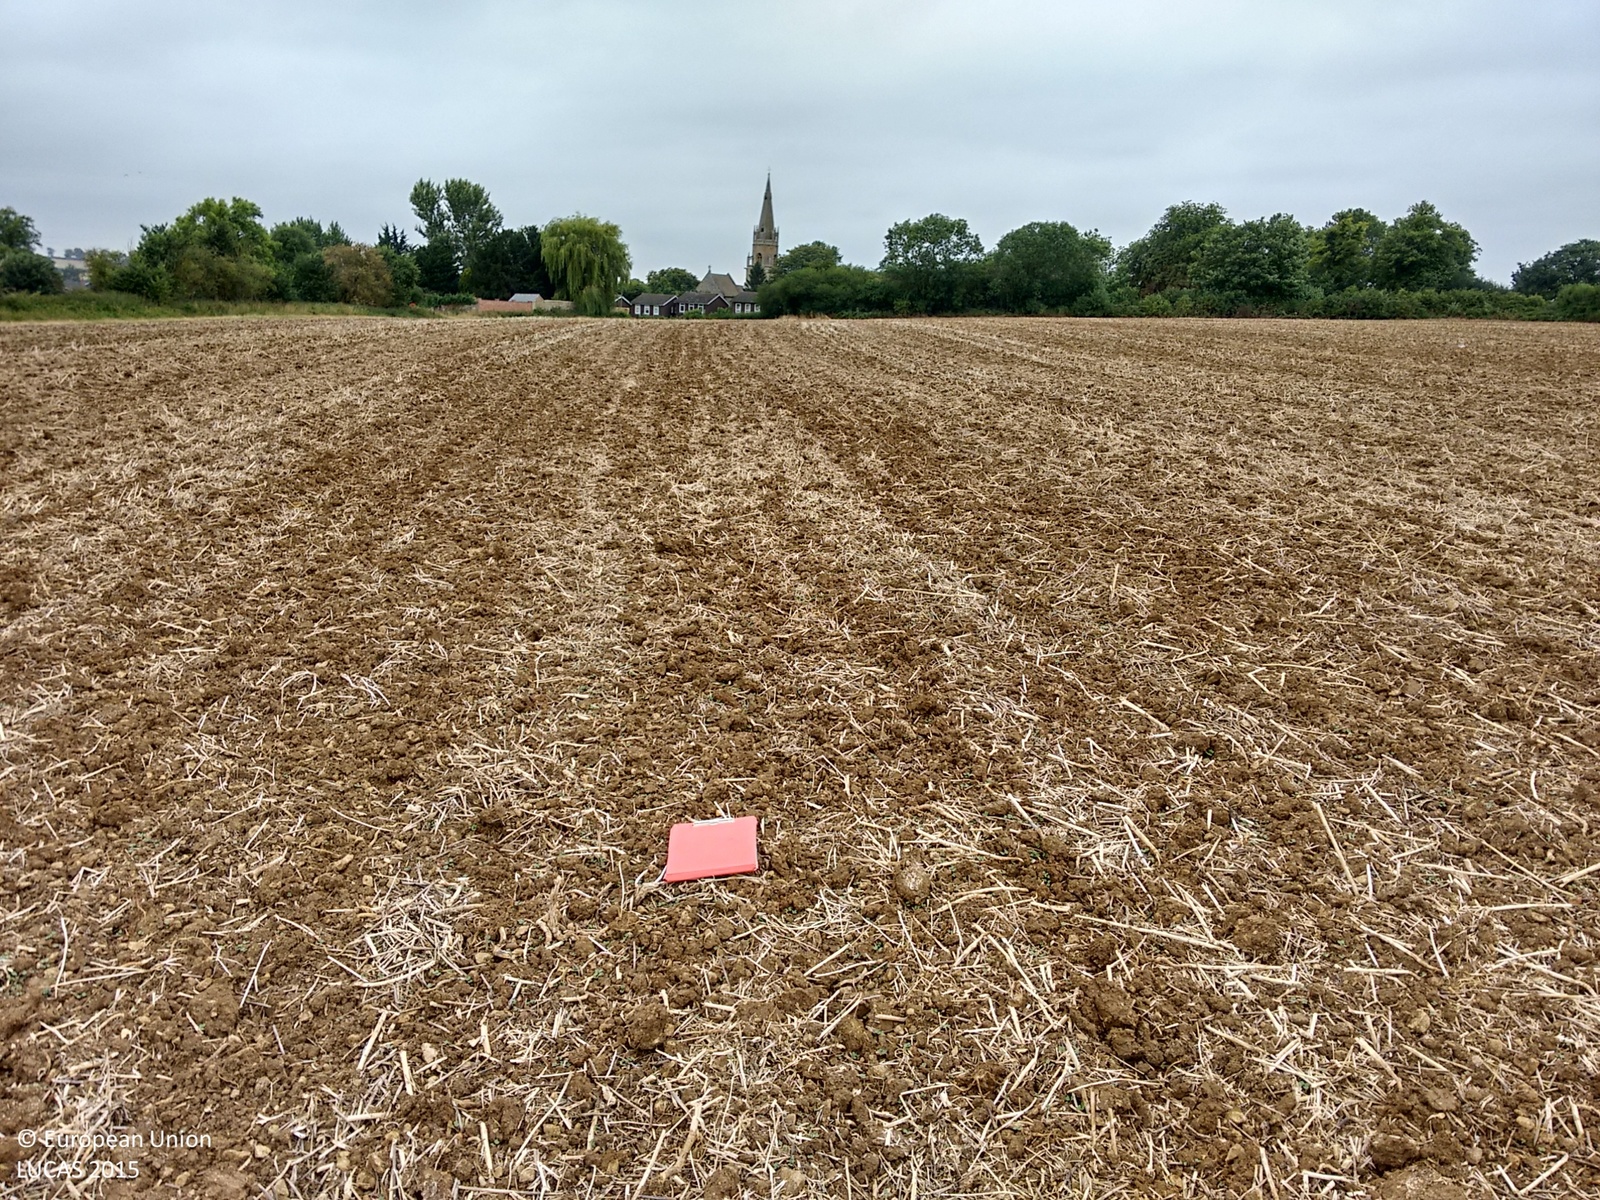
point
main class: Cropland
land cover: Rape and turnip rape
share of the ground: < 10 %
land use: Agriculture (excluding fallow land and kitchen gardens)
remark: Harvested field
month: August
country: GB
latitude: 52.2889
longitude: -0.7285
